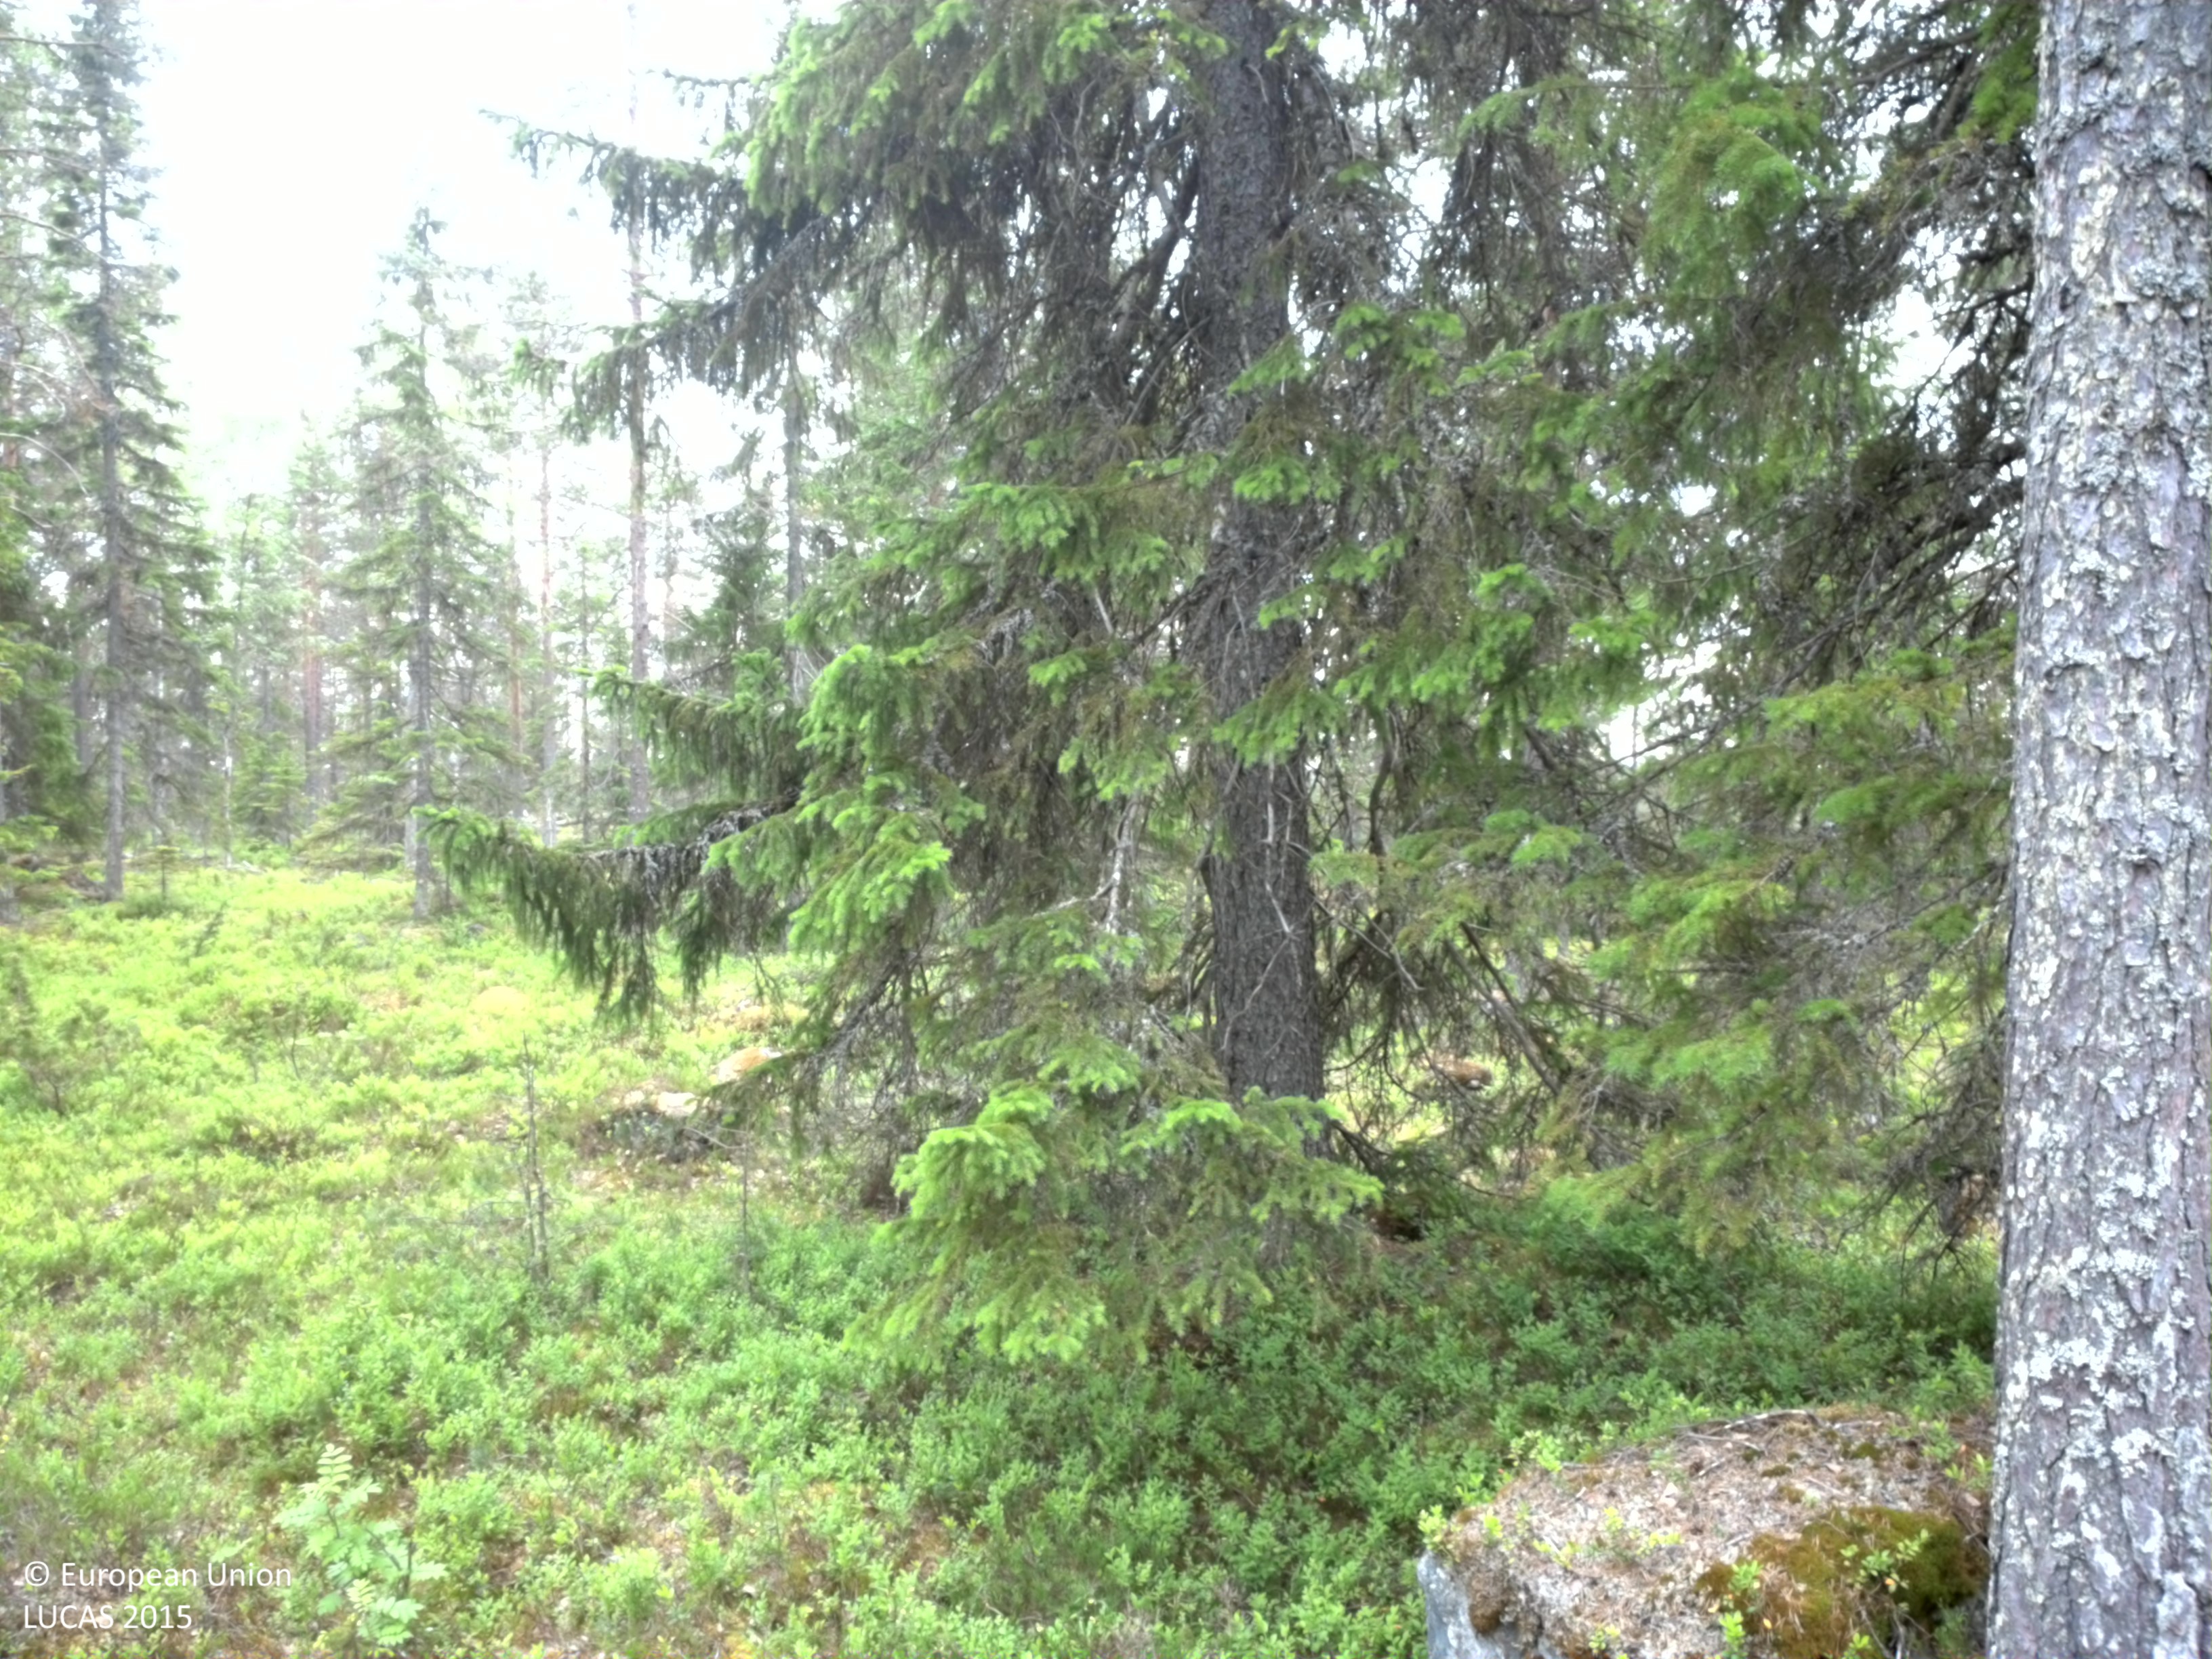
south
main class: Woodland
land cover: Other coniferous woodland
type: boreal forest
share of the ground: 25 - 50 %
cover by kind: coniferous forest trees 50 %, shrubs 45 %, lichens and mosses 5 %
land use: Forestry
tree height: > 5 m
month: July
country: SE
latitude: 64.3744
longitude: 20.8191
